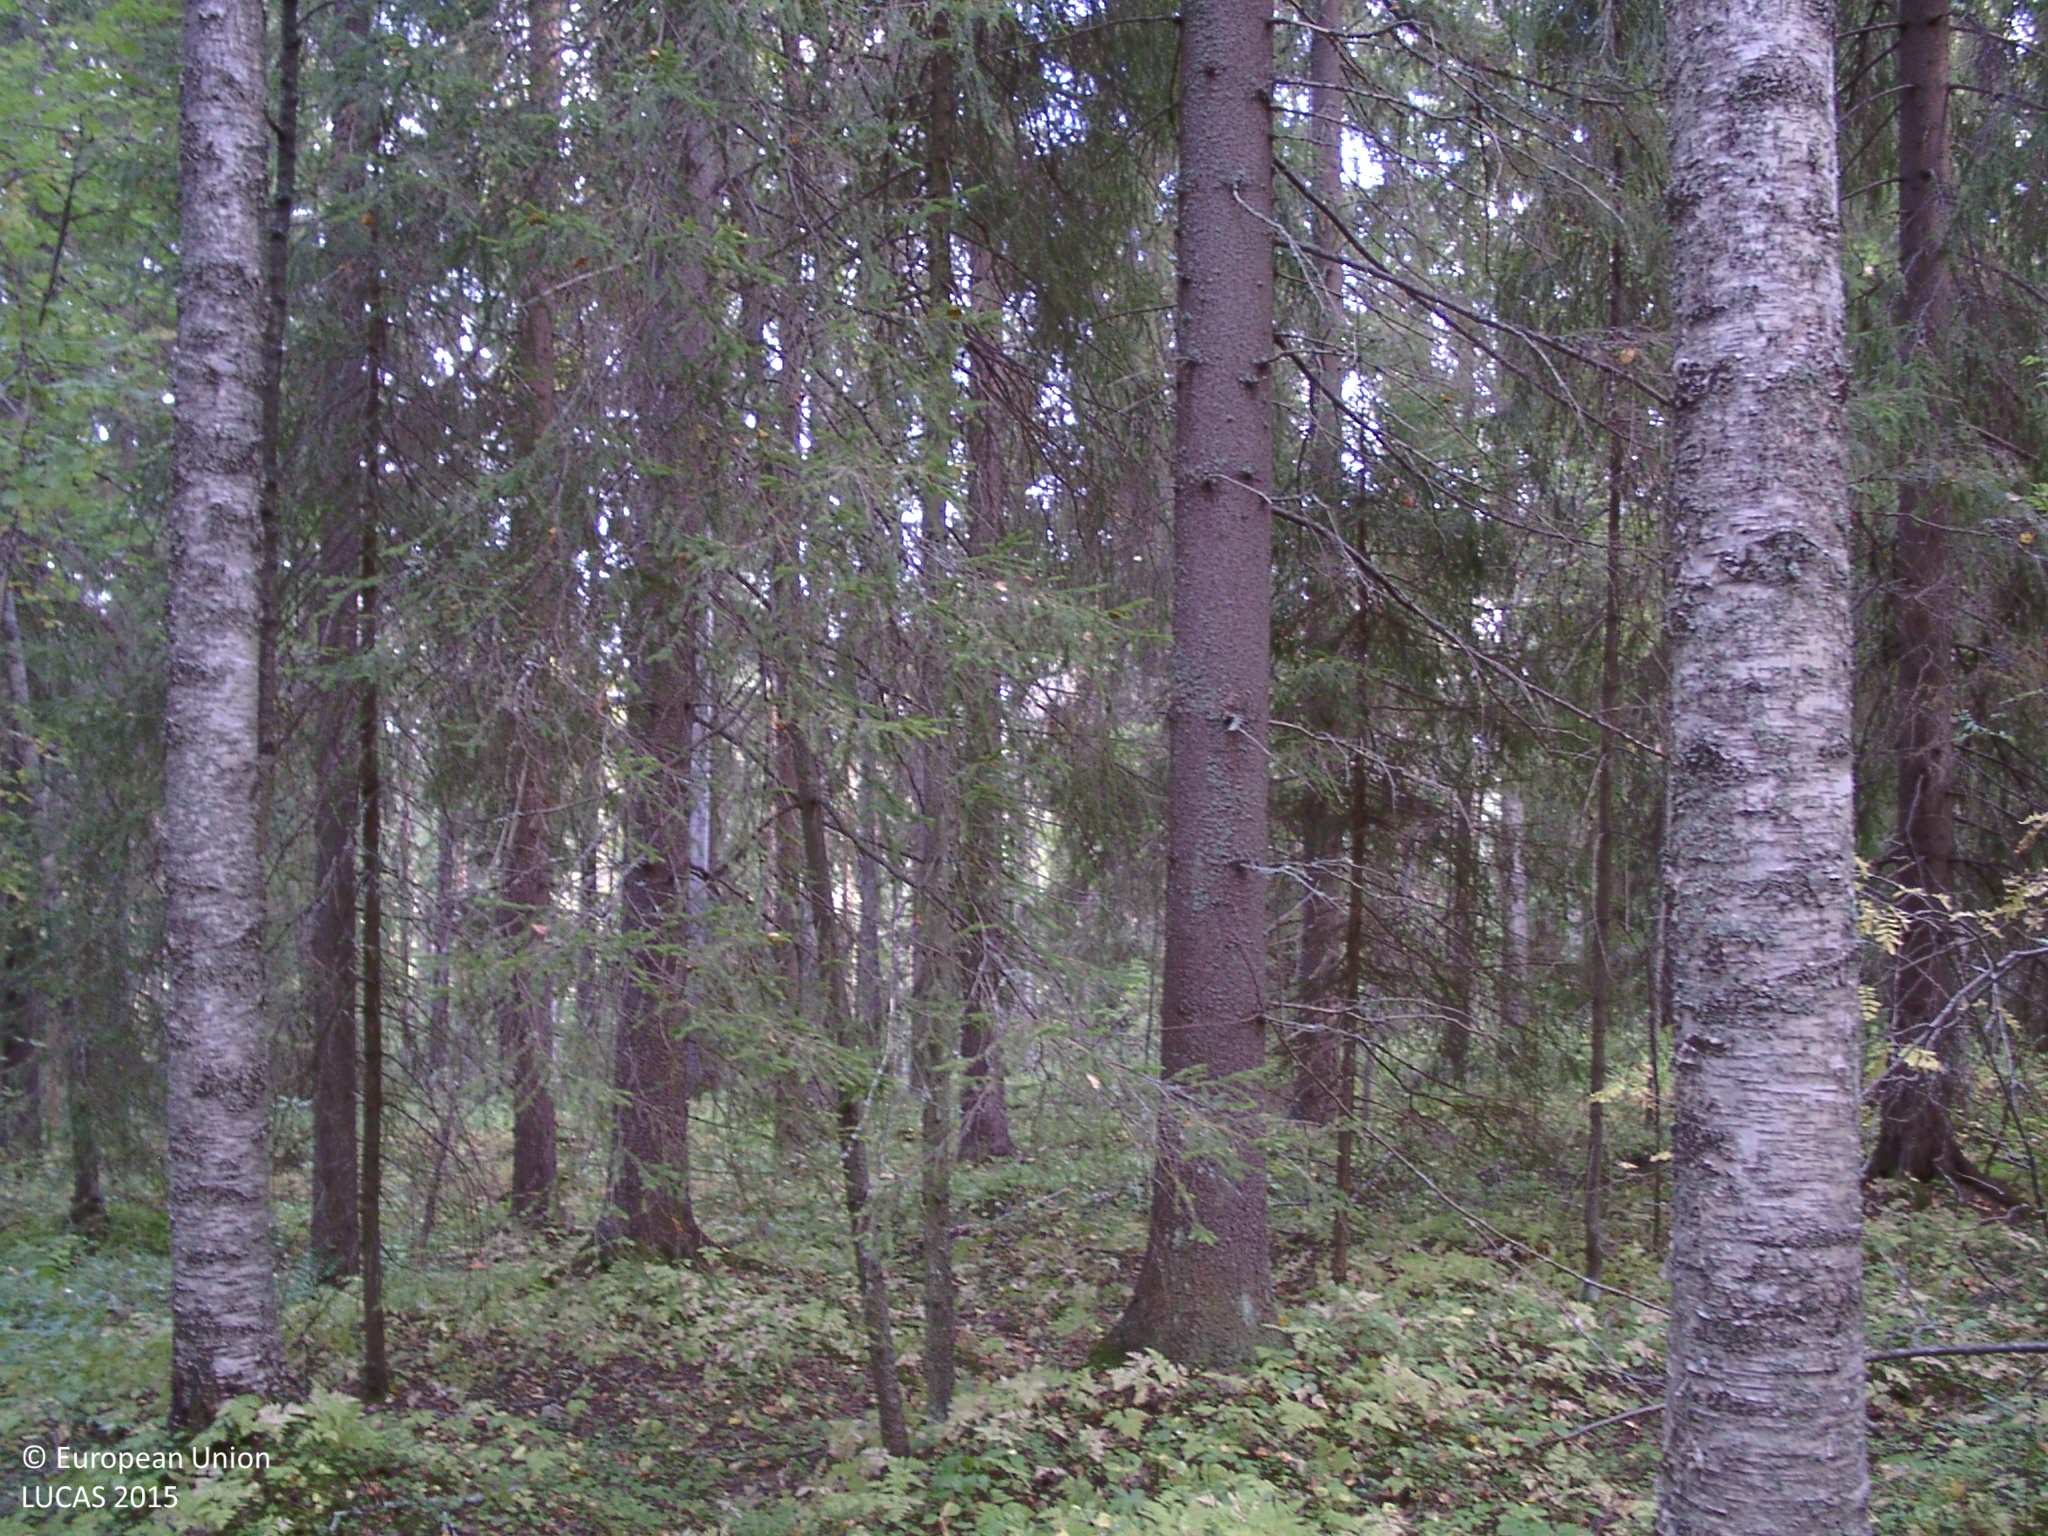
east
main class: Woodland
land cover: Spruce dominated mixed woodland
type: boreal forest
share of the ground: > 75 %
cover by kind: coniferous forest trees 45 %, broadleaved forest trees 40 %, herbaceous plants 10 %, lichens and mosses 5 %
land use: Forestry
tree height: > 5 m
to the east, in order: Spruce dominated mixed woodland; Other mixed woodland; Spruce dominated mixed woodland; Spruce dominated coniferous woodland; Shrubland without tree cover; Shrubland with sparse tree cover; Ditches and canals
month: September
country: FI
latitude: 62.6051
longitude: 25.7604
